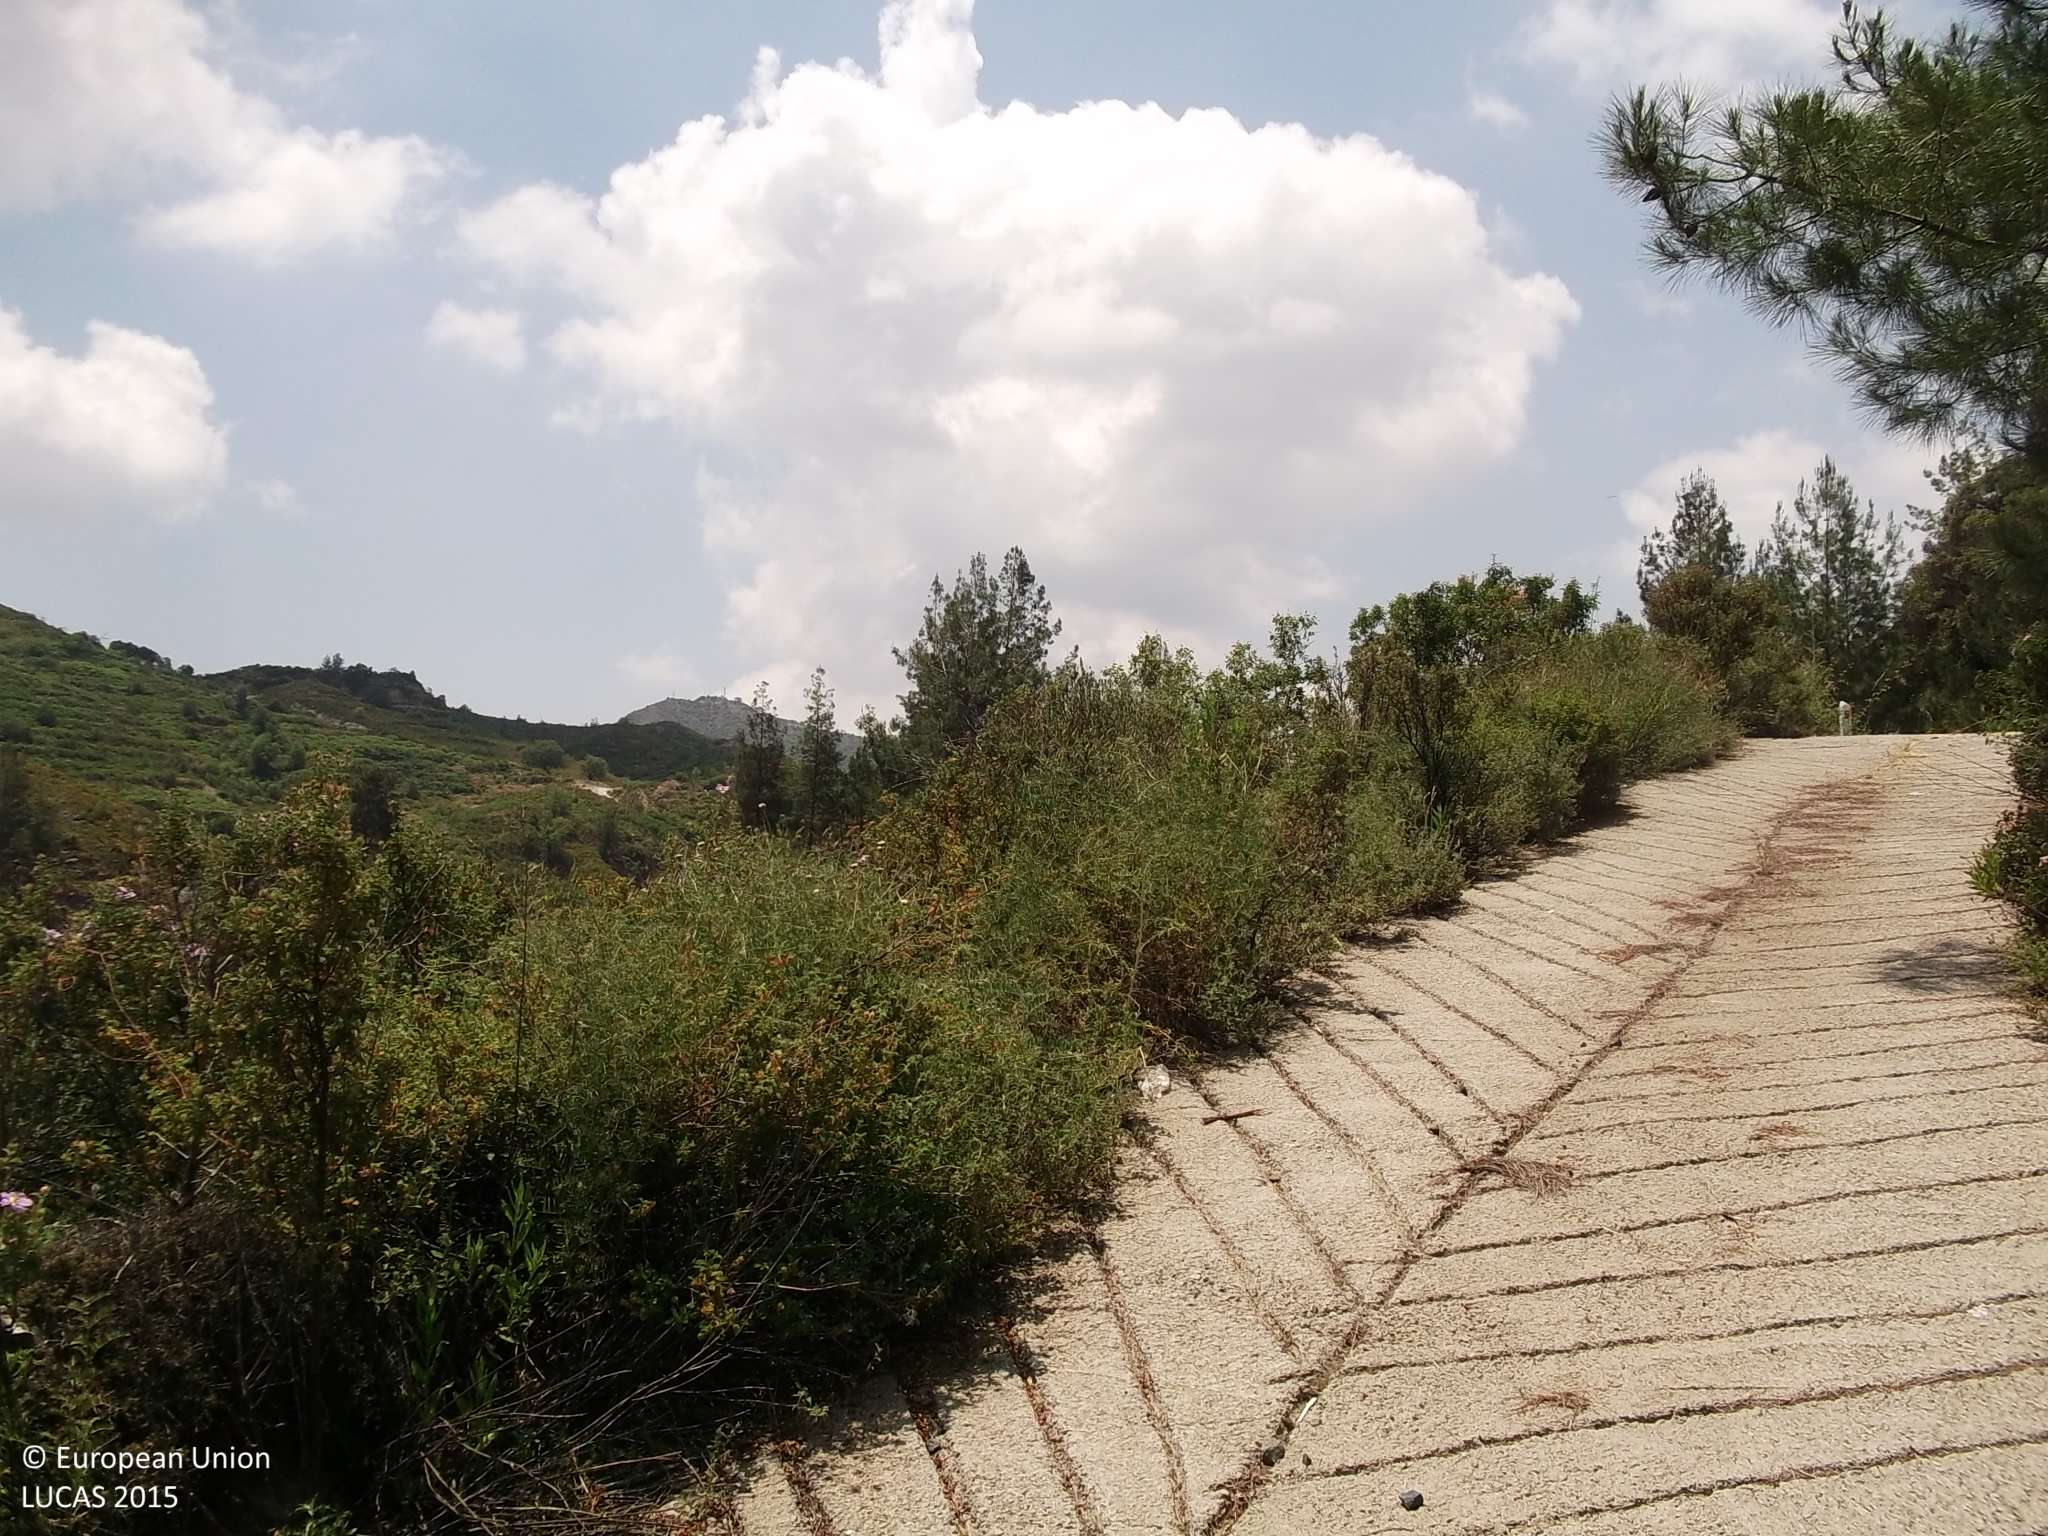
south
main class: Shrubland
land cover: Shrubland with sparse tree cover
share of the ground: > 75 %
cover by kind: shrubs 95 %, coniferous forest trees 5 %
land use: Semi-natural and natural areas not in use
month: June
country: CY
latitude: 34.9024
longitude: 32.9424
